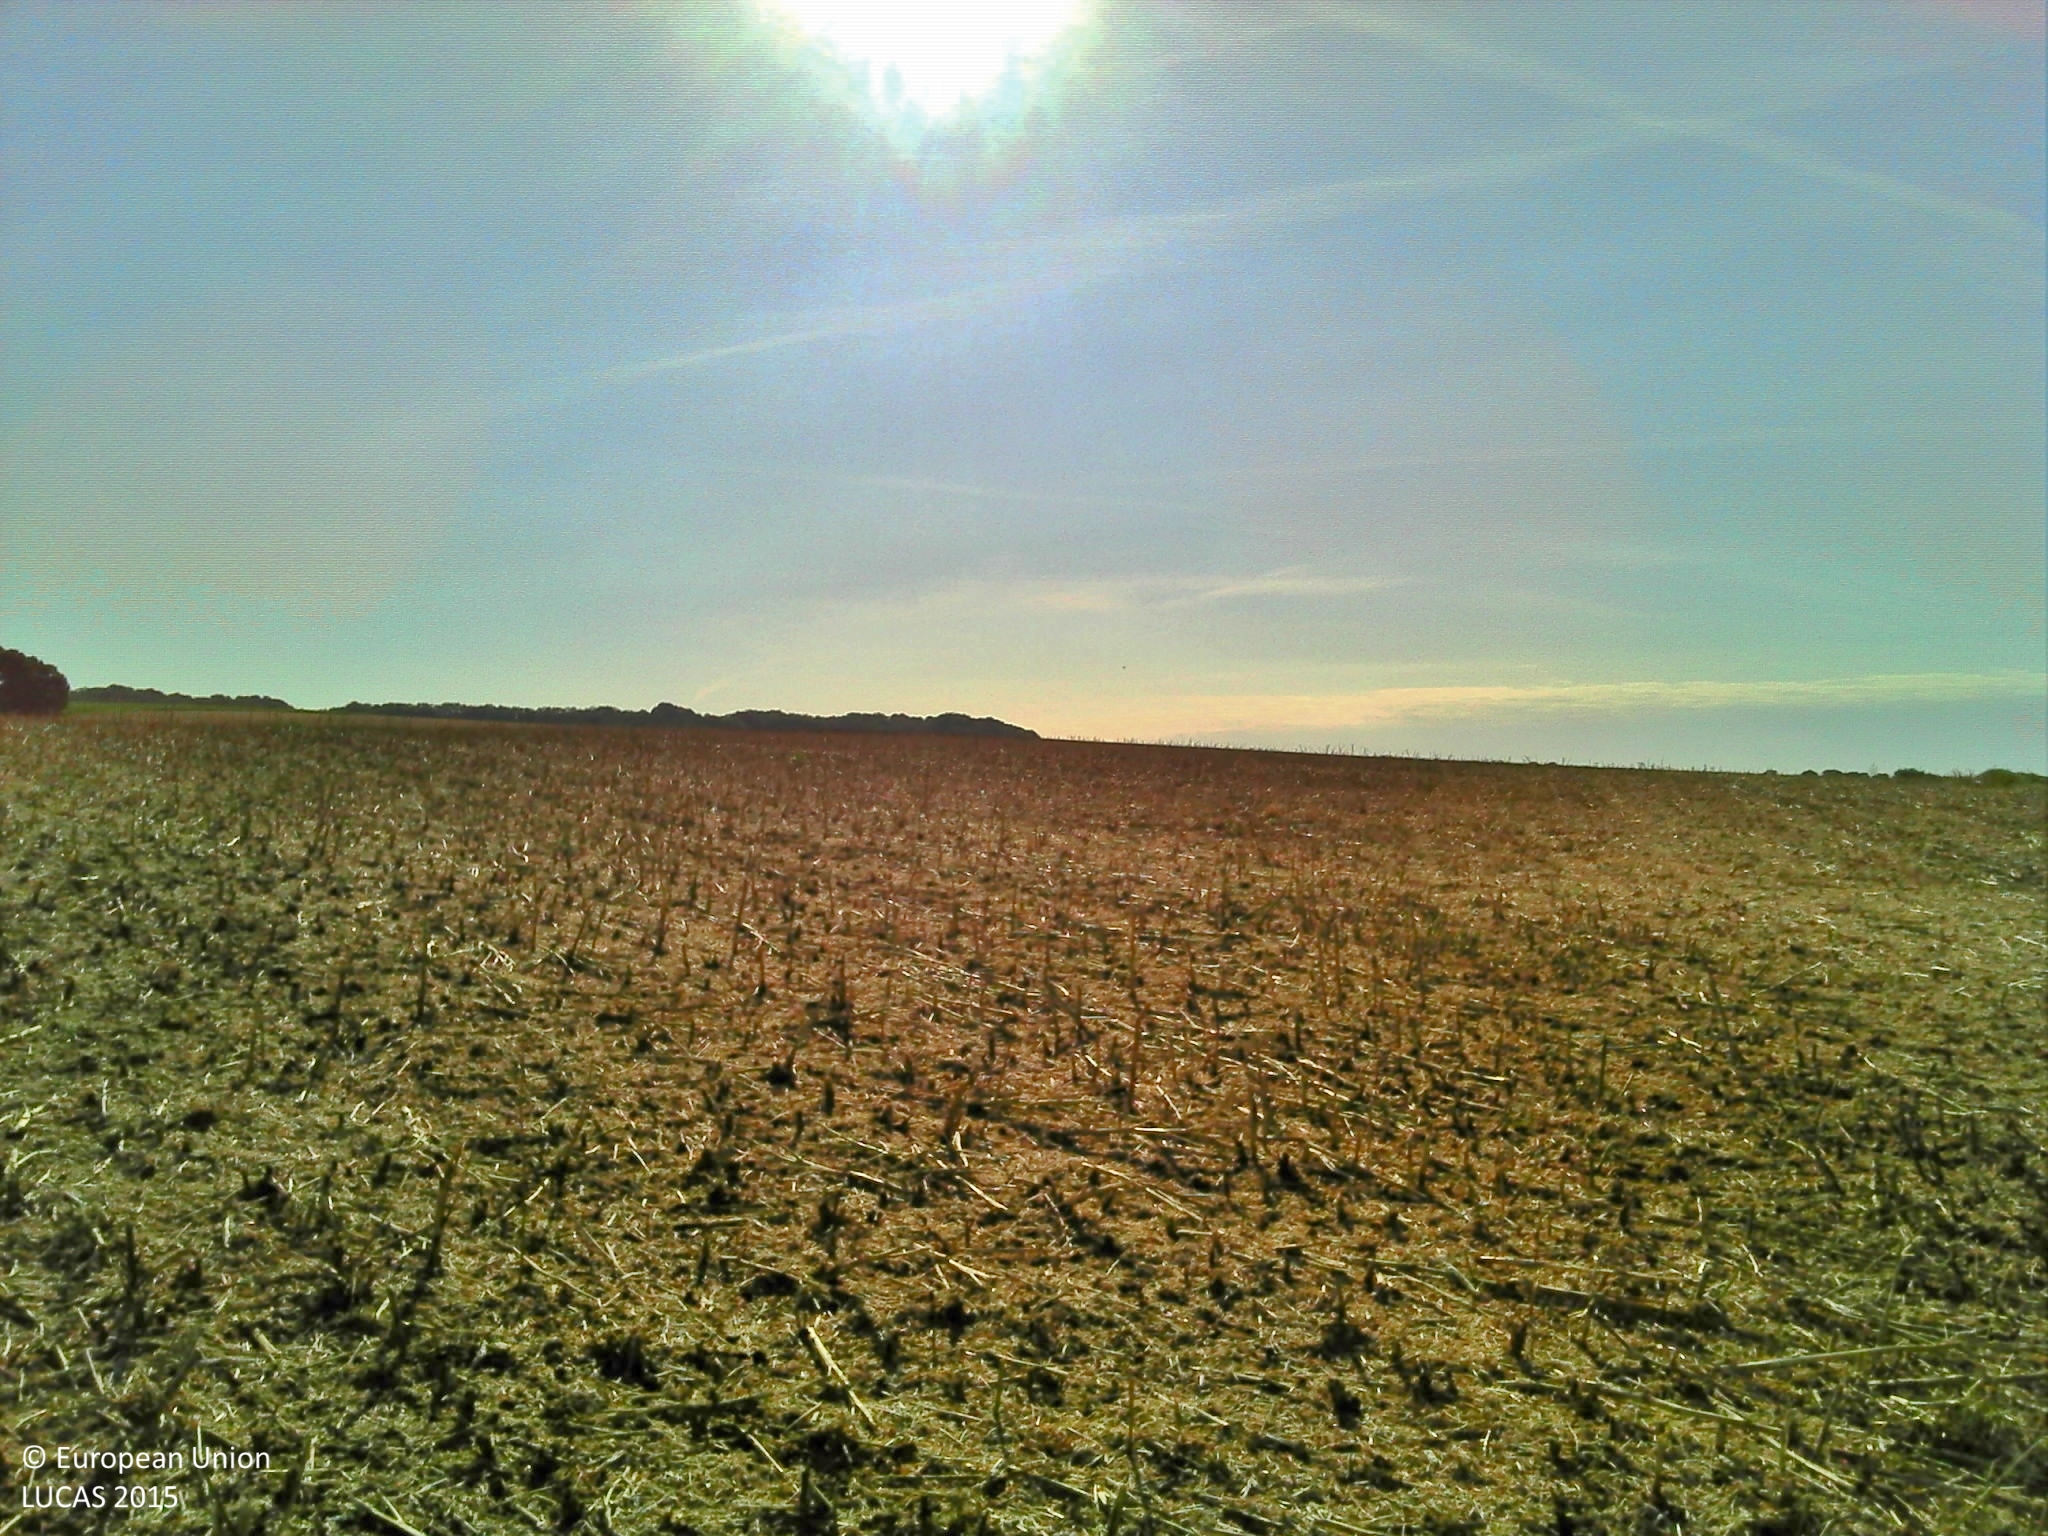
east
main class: Cropland
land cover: Rape and turnip rape
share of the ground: > 75 %
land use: Agriculture (excluding fallow land and kitchen gardens)
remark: Harvested field
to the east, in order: Rape and turnip rape; Ditches and canals; Grass margins; Dry pulses
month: July
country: FR
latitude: 49.2598
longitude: 2.6377
